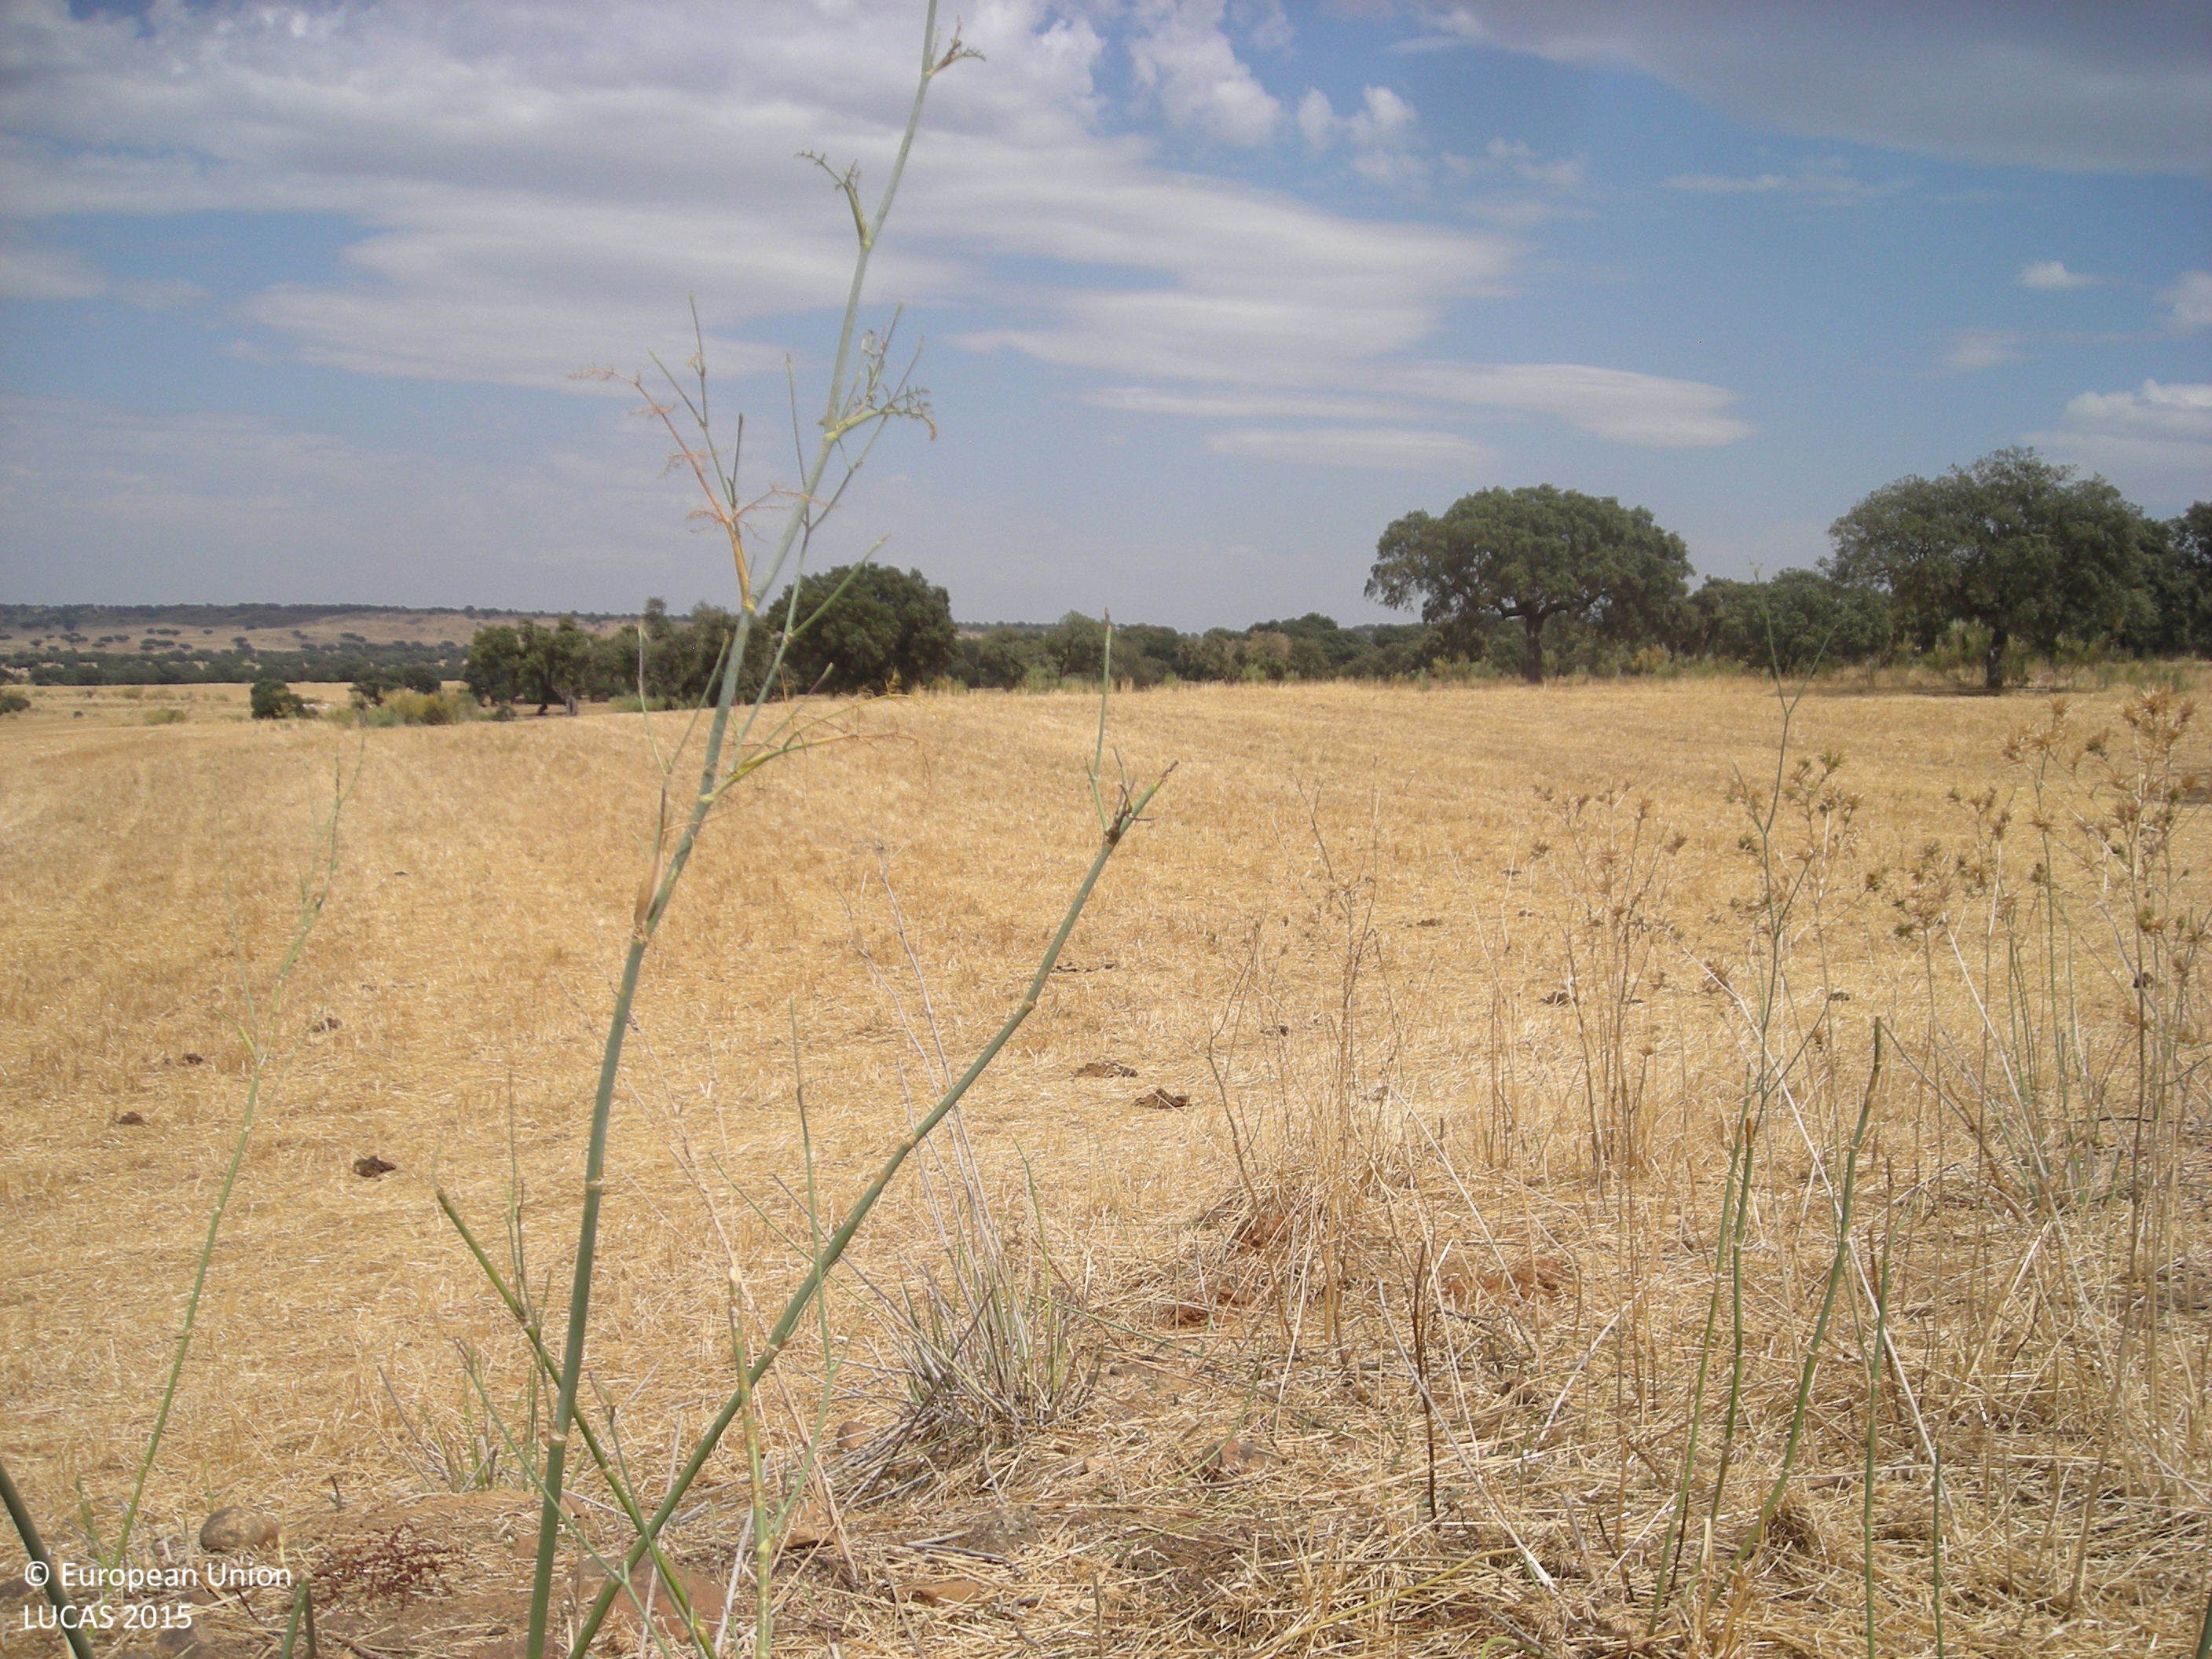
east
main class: Woodland
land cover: Broadleaved woodland
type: broadleaved evergreen forest
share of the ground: > 75 %
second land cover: Grassland without tree/shrub cover
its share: 50 - 75 %
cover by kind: broadleaved forest trees 70 %, herbaceous plants 30 %
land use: Forestry
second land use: Agriculture (excluding fallow land and kitchen gardens)
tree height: > 5 m
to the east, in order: Broadleaved woodland; Grassland without tree/shrub cover
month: July
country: ES
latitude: 39.2023
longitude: -5.5533
